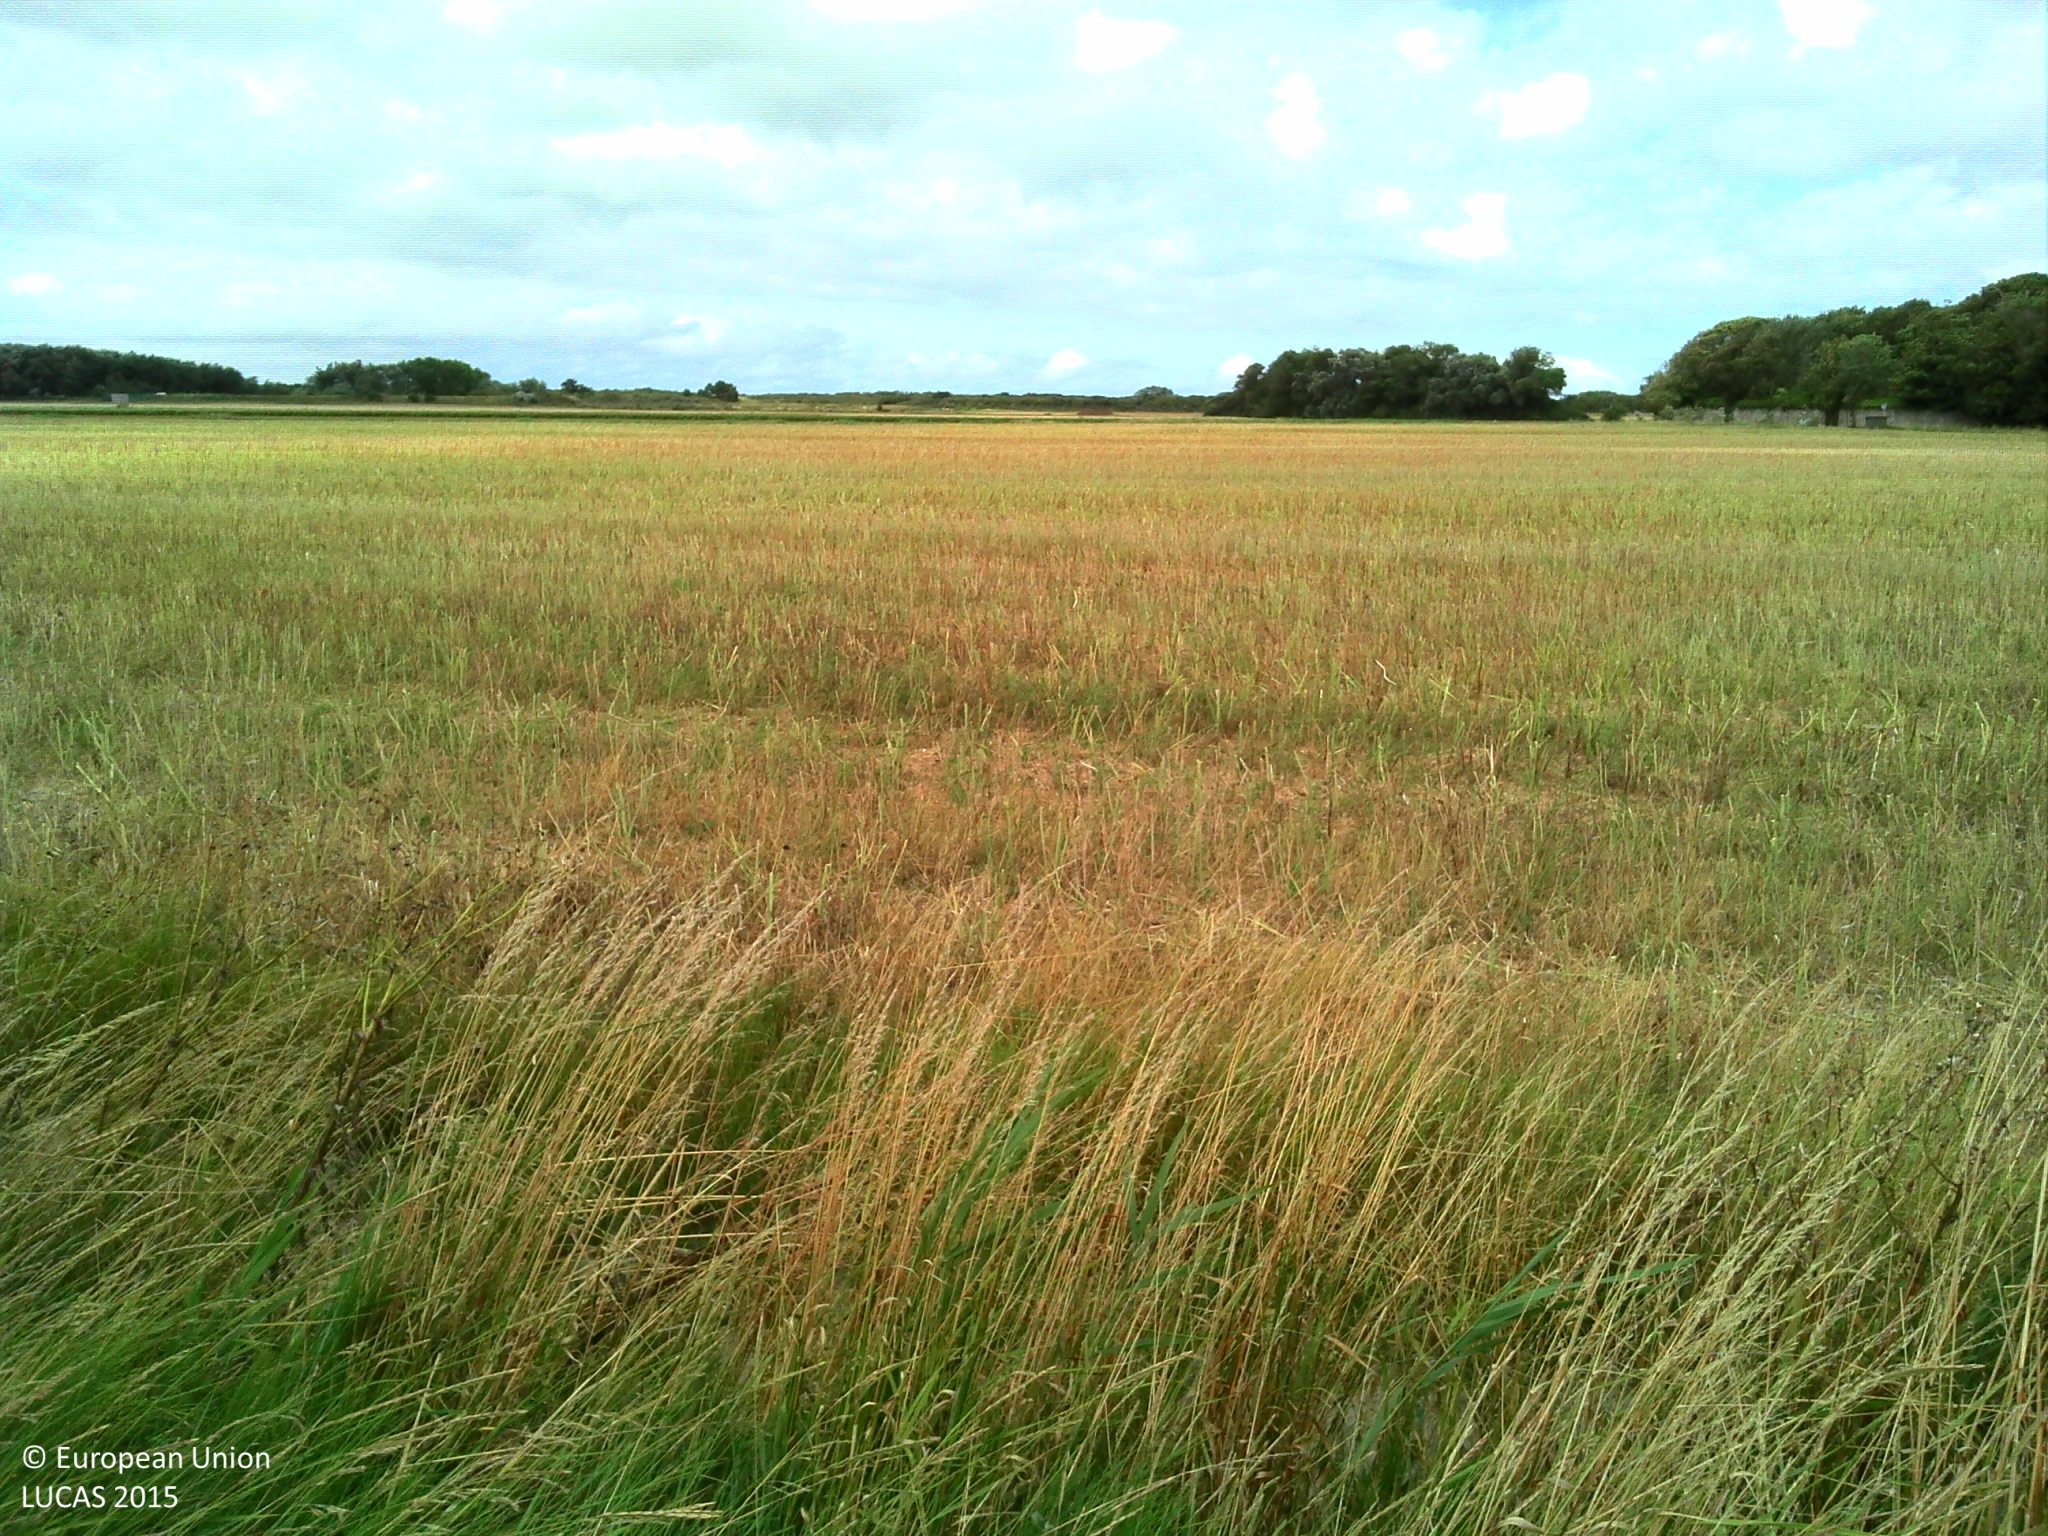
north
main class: Cropland
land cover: Common wheat
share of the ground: 50 - 75 %
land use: Agriculture (excluding fallow land and kitchen gardens)
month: August
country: FR
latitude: 50.9885
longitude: 2.0206
